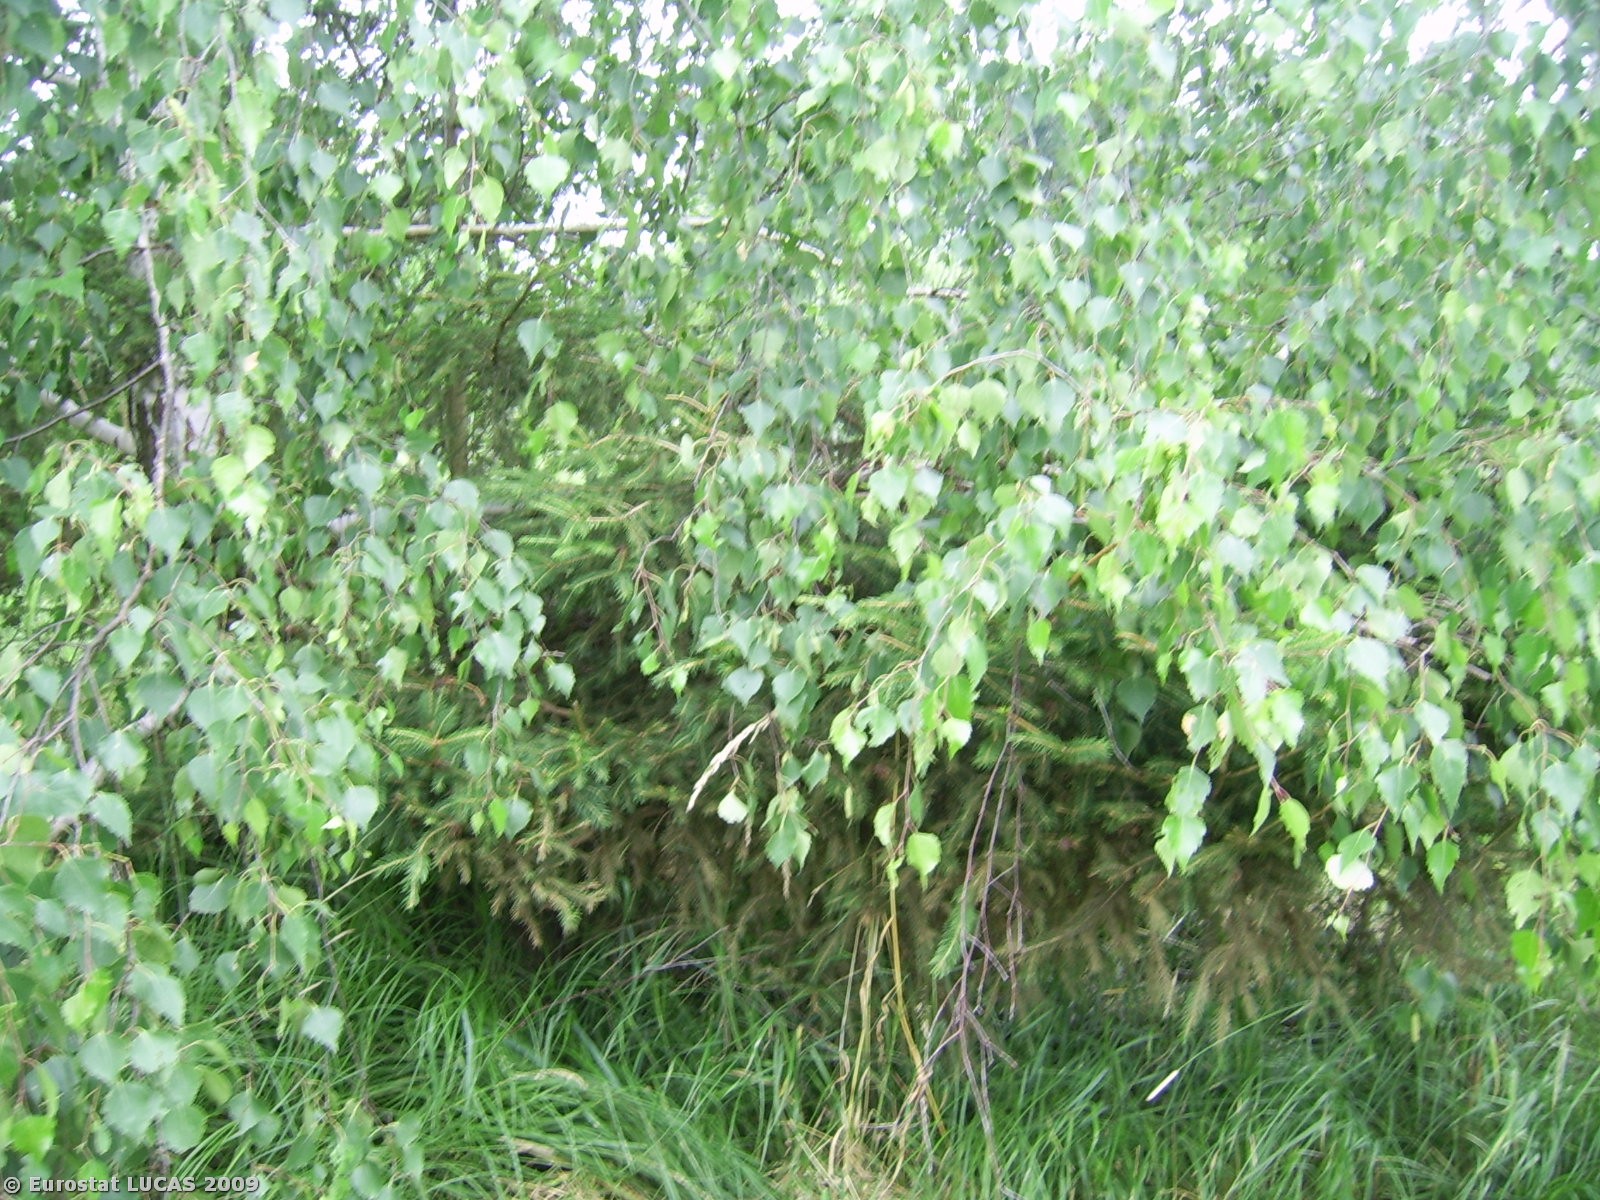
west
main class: Cropland
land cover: Common wheat
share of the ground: > 75 %
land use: Agriculture (excluding fallow land and kitchen gardens)
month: June
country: PL
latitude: 51.5000
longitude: 17.3443
